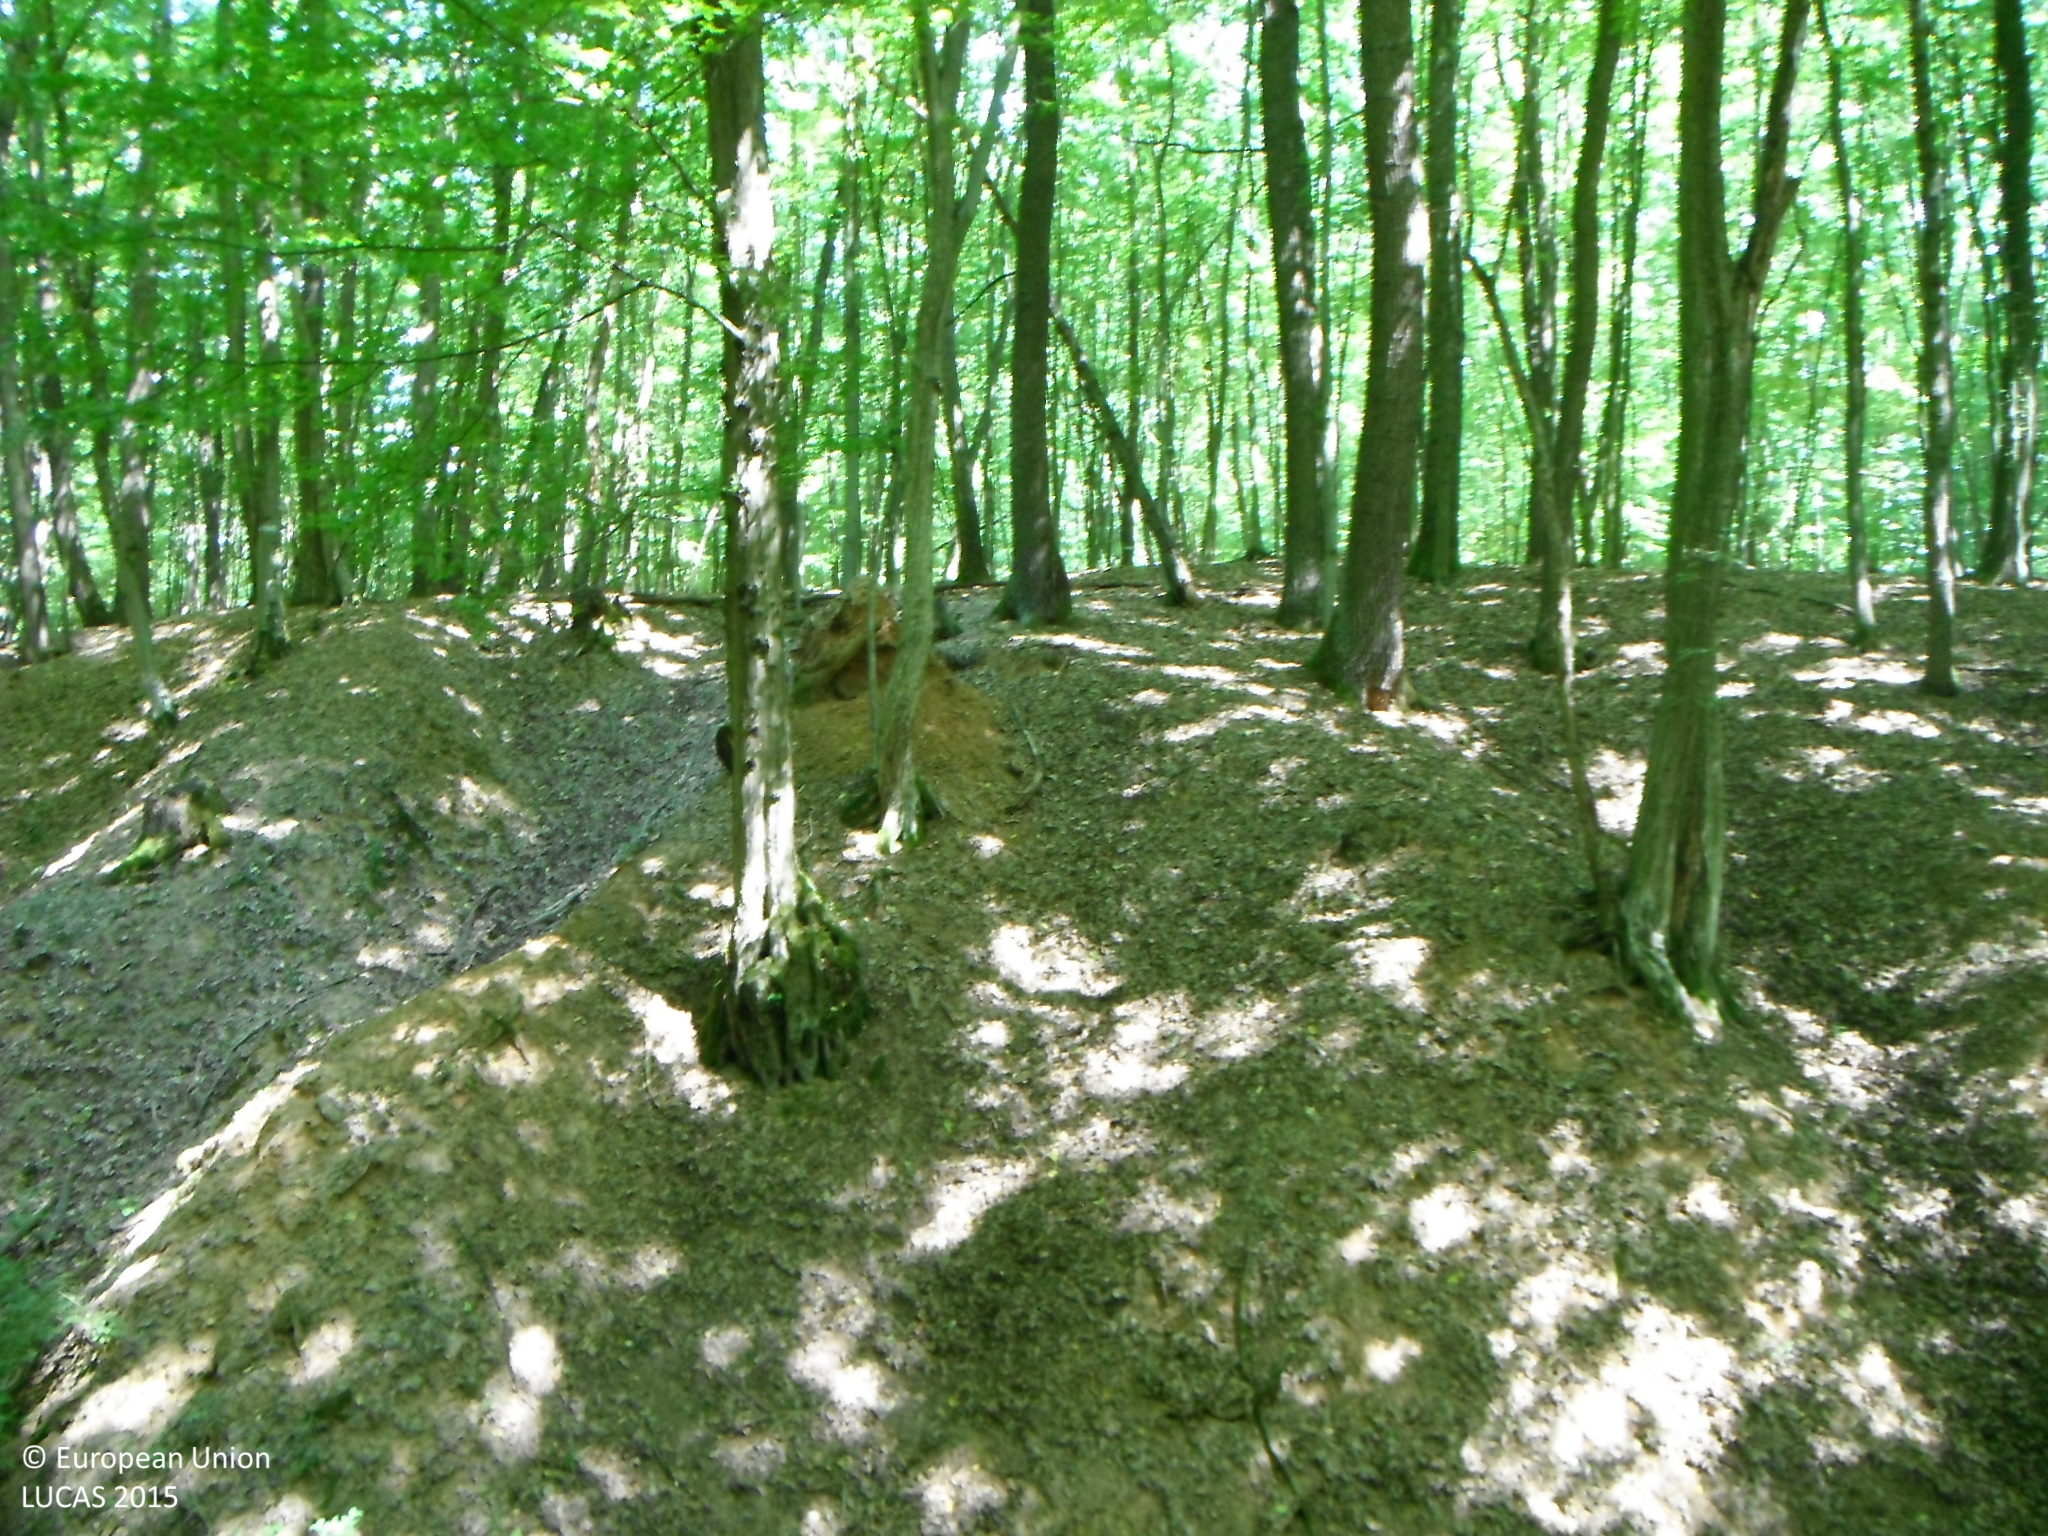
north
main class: Woodland
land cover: Broadleaved woodland
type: mesophytic deciduous forest
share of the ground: > 75 %
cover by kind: broadleaved forest trees 100 %
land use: Forestry
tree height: > 5 m
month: July
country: SK
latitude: 48.2484
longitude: 19.0569
